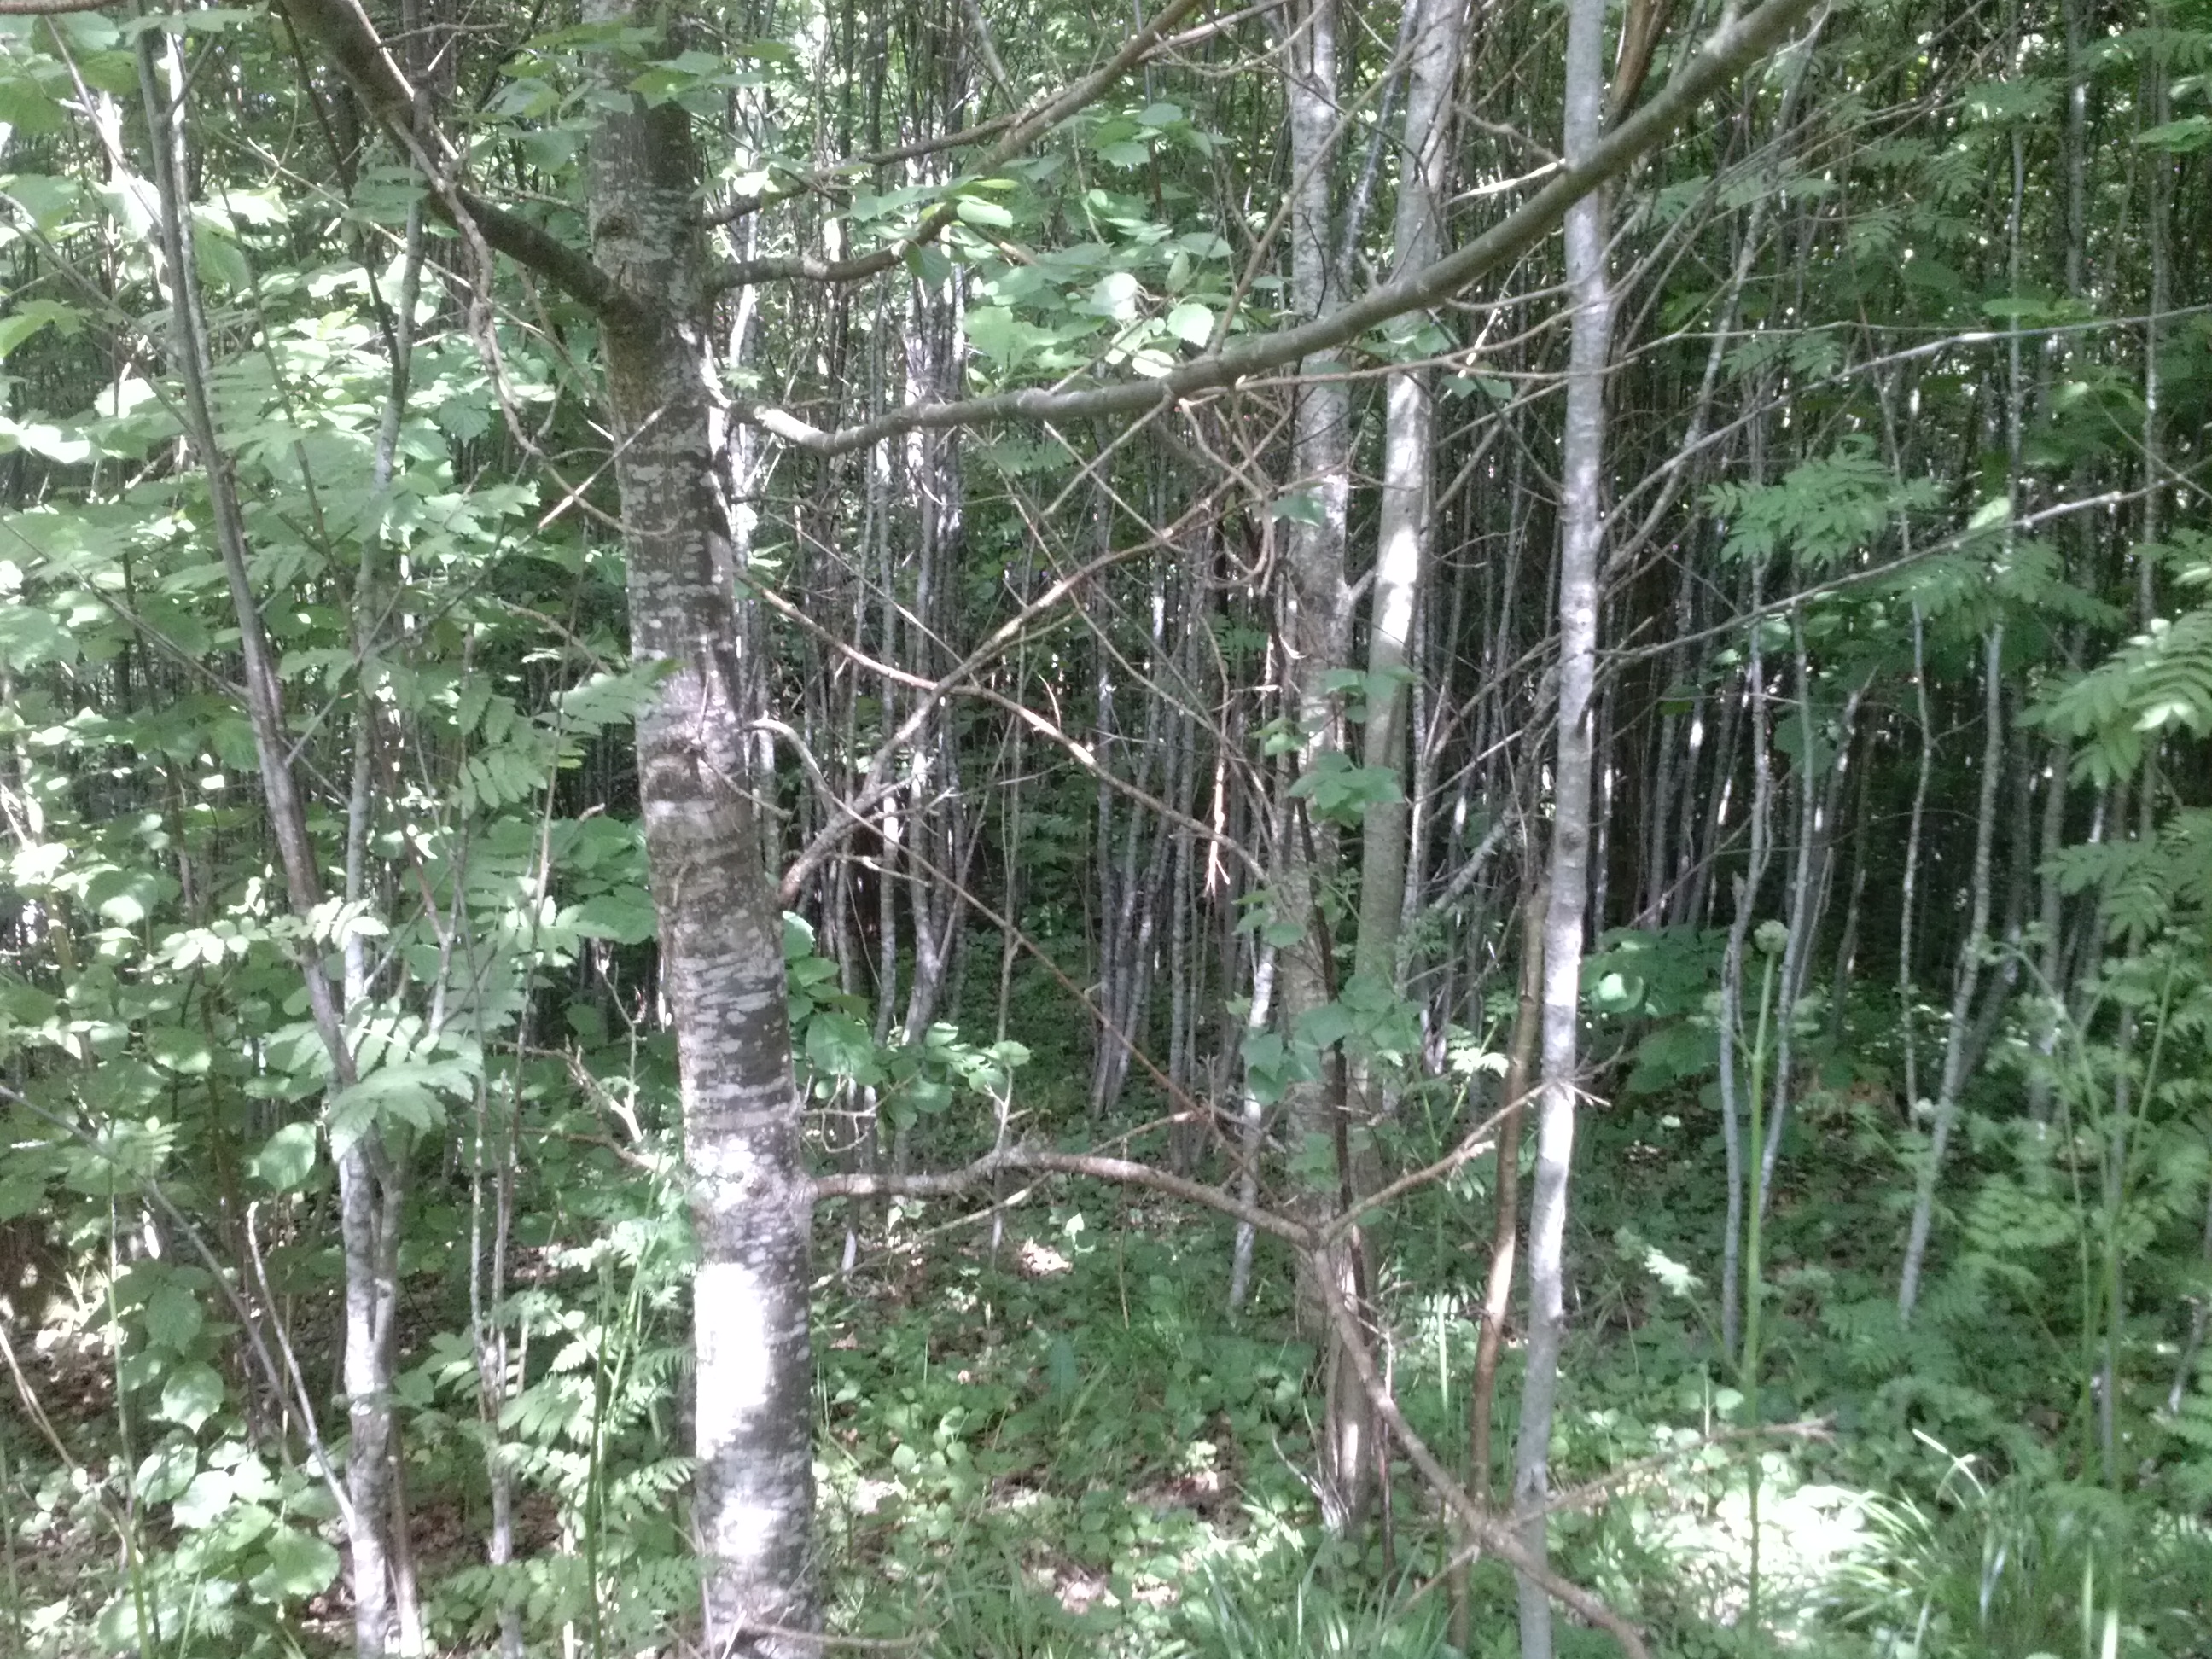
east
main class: Woodland
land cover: Broadleaved woodland
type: non-riverine alder, birch or aspen forest
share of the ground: > 75 %
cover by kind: broadleaved forest trees 100 %
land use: Forestry
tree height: > 5 m
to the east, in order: Broadleaved woodland; Pine dominated mixed woodland
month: June
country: LV
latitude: 56.4052
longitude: 27.4023
